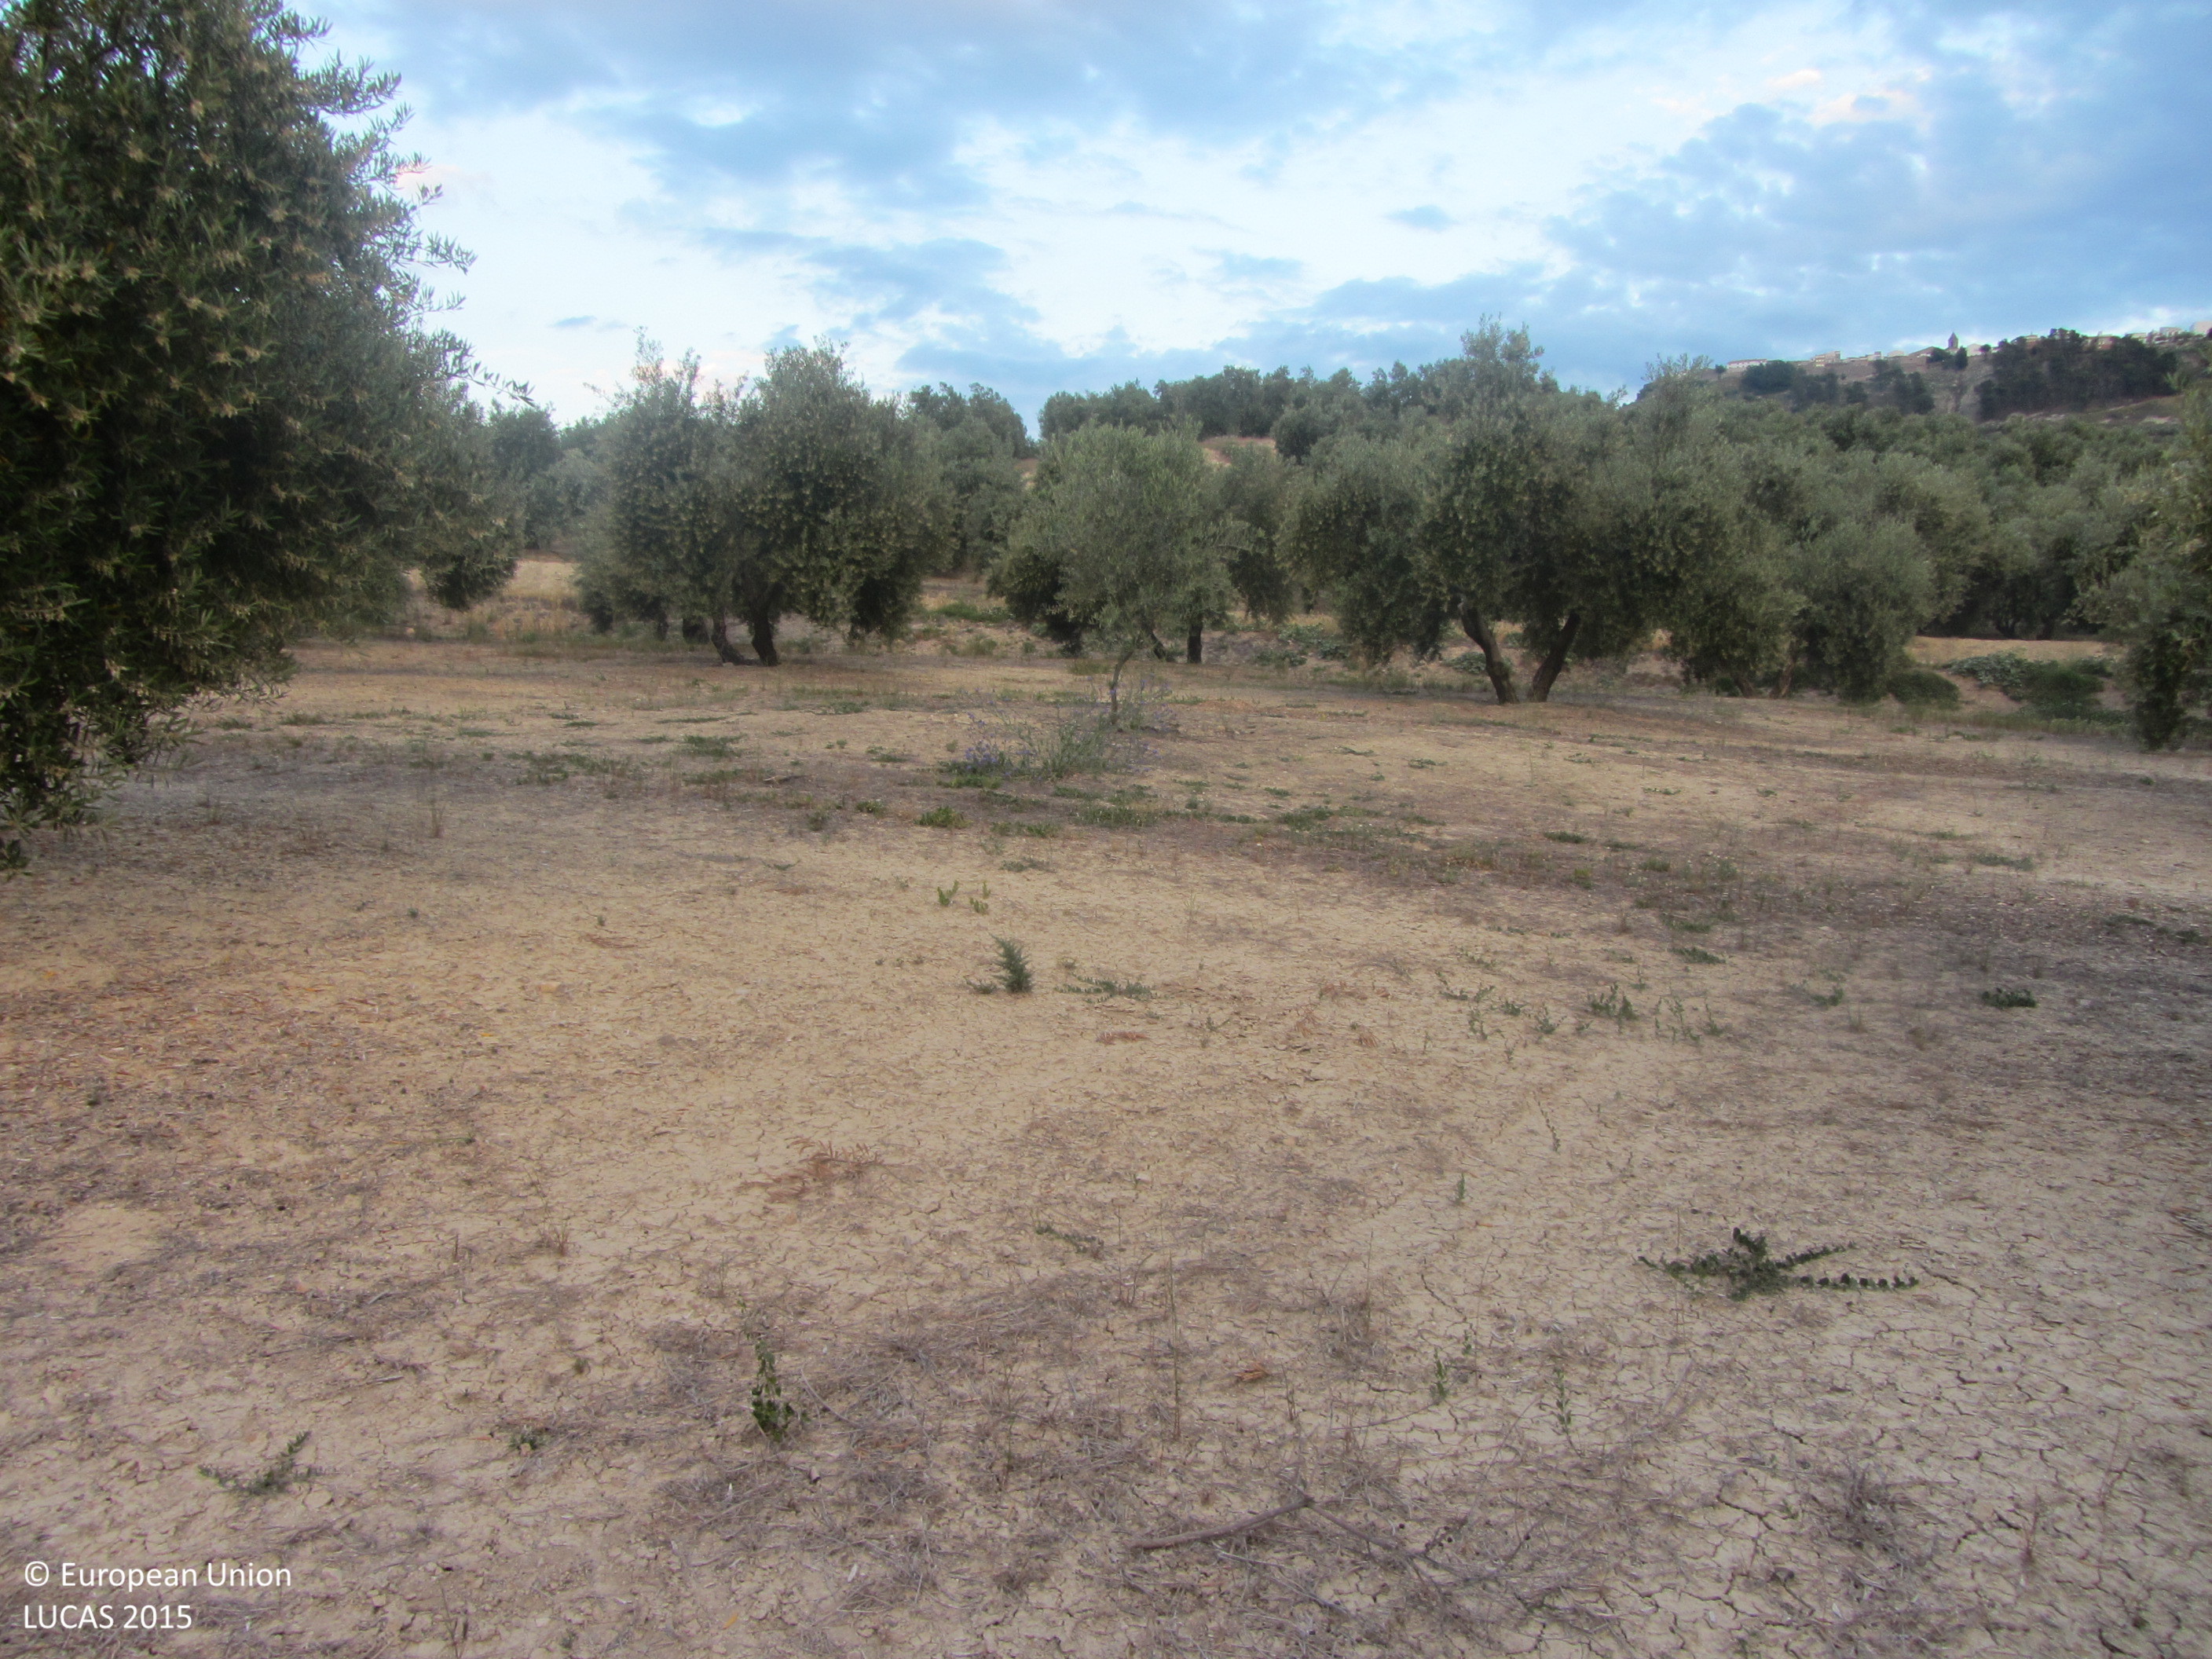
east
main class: Cropland
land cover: Olive groves
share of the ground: 25 - 50 %
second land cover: Other bare soil
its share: > 75 %
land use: Agriculture (excluding fallow land and kitchen gardens)
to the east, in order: Olive groves; Other bare soil; Grass margins; Tracks; Ditches and canals; Olive groves; Tracks; Ditches and canals; Olive groves
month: May
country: ES
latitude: 38.1651
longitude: -3.0449
